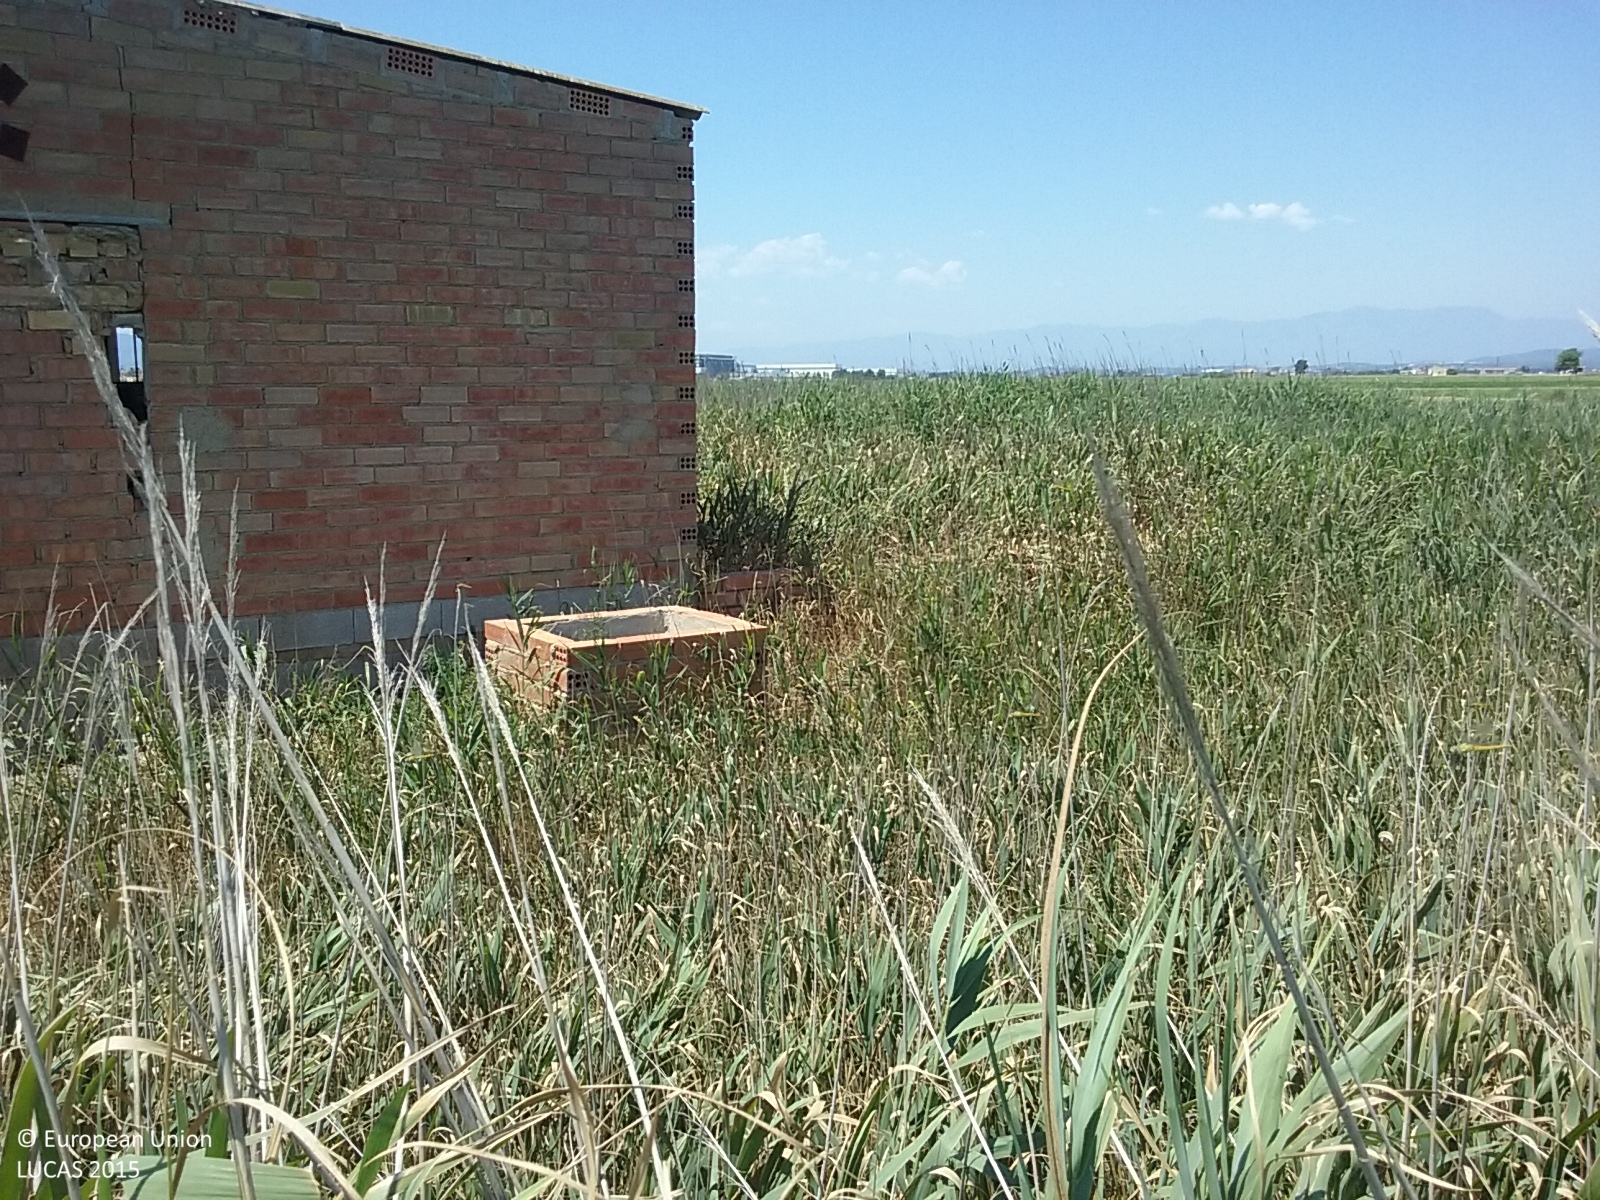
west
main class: Cropland
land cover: Rice
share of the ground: 25 - 50 %
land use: Agriculture (excluding fallow land and kitchen gardens)
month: June
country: ES
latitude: 40.7368
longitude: 0.7234
